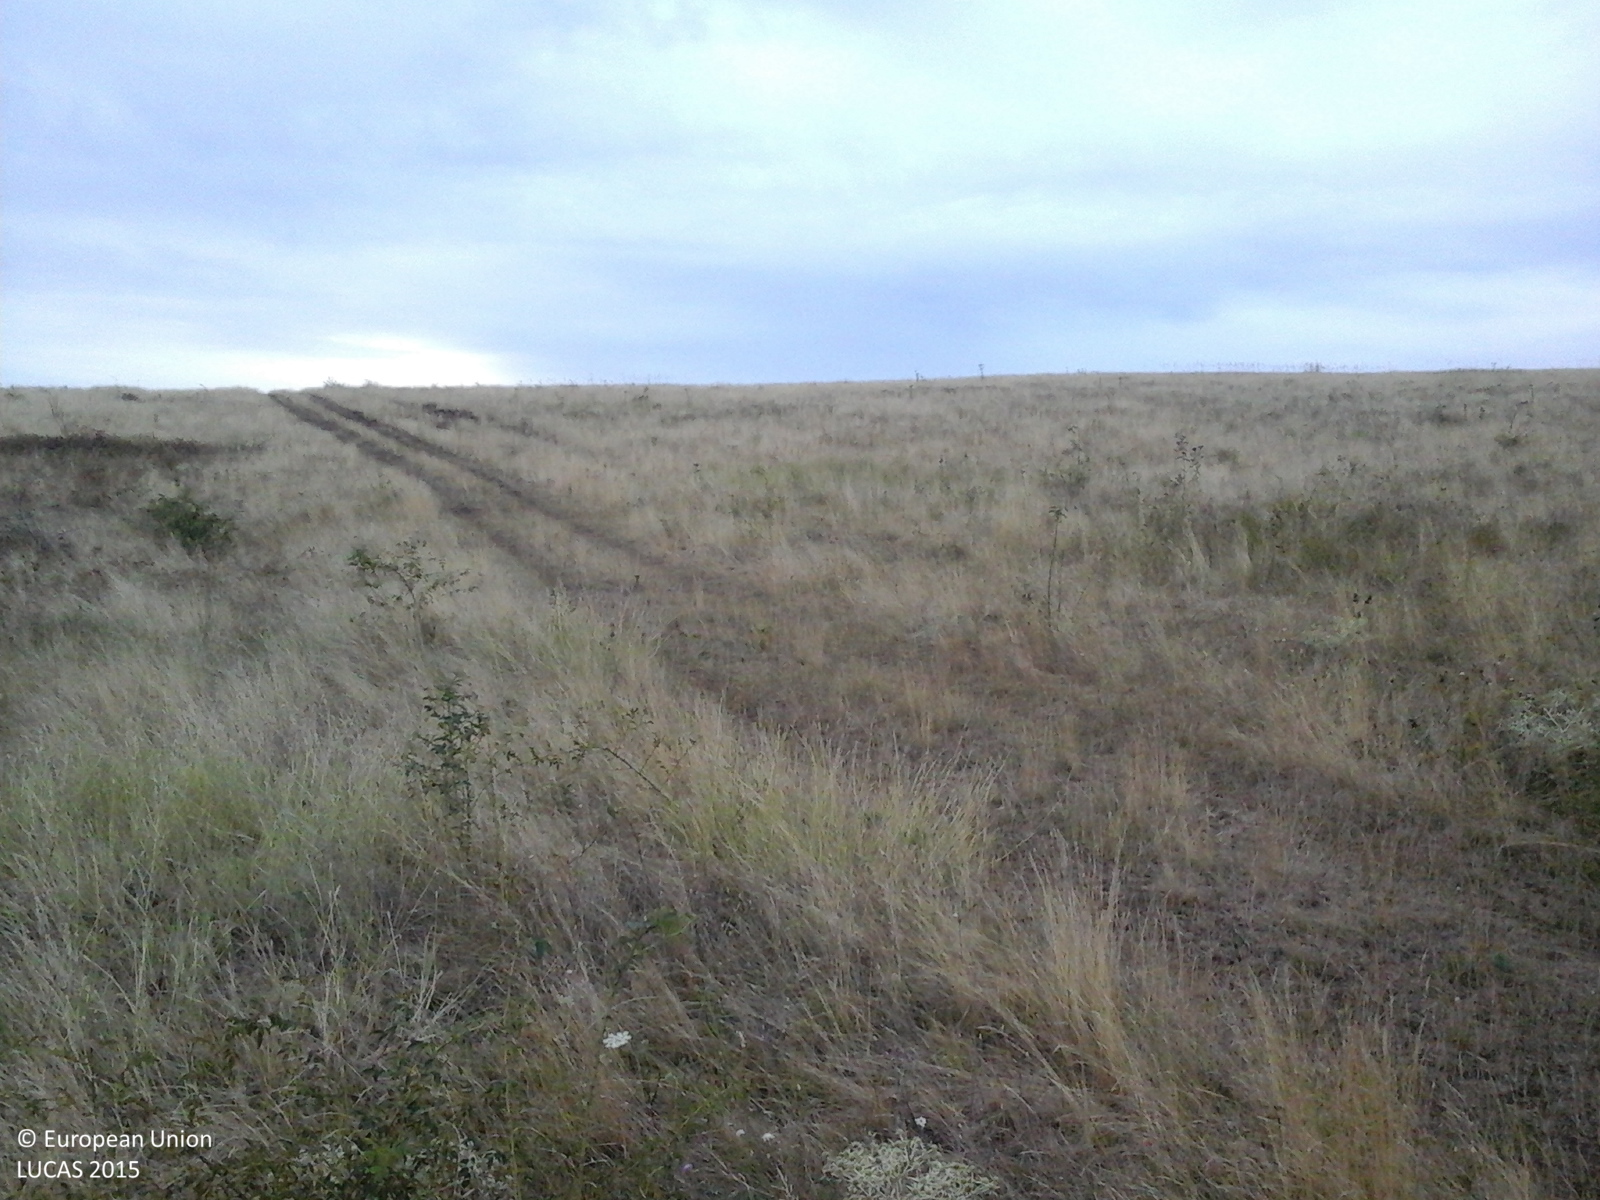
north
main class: Grassland
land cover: Grassland with sparse tree/shrub cover
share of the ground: > 75 %
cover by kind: herbaceous plants 85 %, shrubs 10 %, broadleaved forest trees 5 %
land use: Agriculture (excluding fallow land and kitchen gardens)
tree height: < 5 m
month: August
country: RO
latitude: 45.8317
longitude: 21.5566
